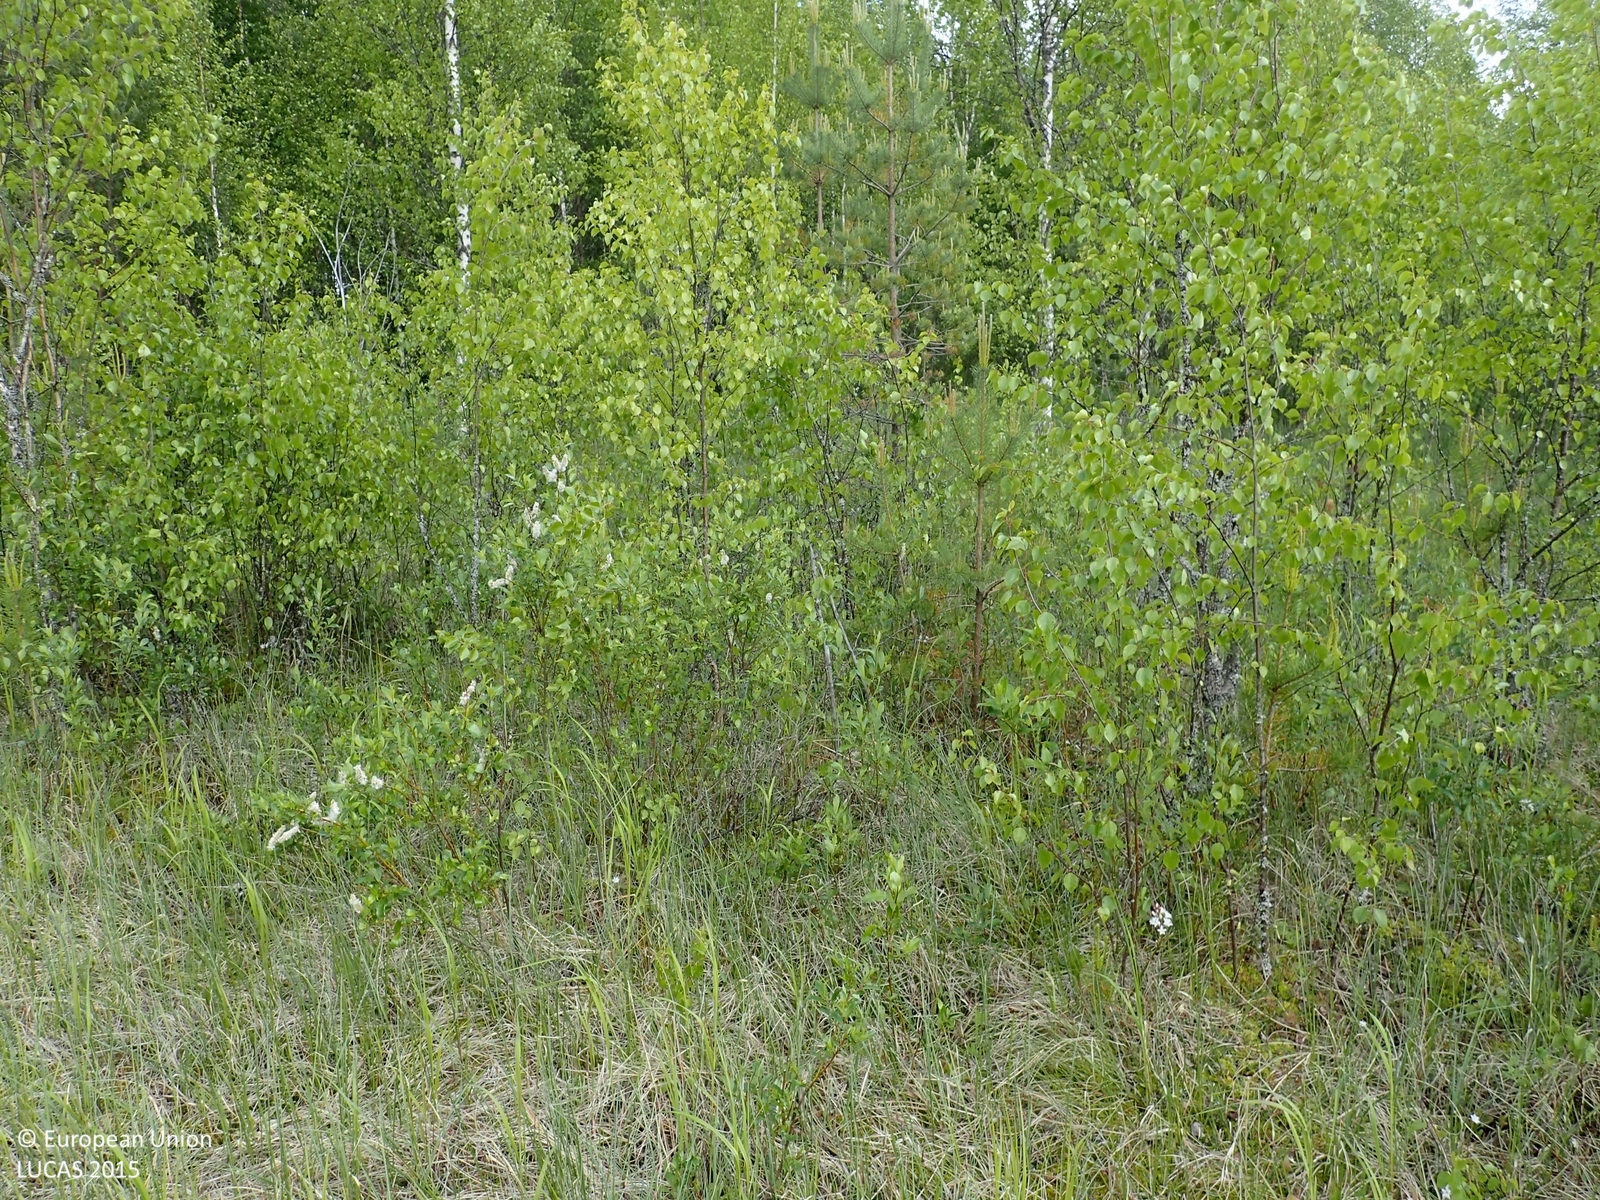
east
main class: Woodland
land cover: Pine dominated mixed woodland
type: mire and swamp forests
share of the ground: 10 - 25 %
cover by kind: herbaceous plants 70 %, broadleaved forest trees 10 %, shrubs 10 %, coniferous forest trees 5 %, lichens and mosses 5 %
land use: Forestry
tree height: < 5 m
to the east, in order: Pine dominated mixed woodland; Grass margins; Ditches and canals; Grass margins; Broadleaved woodland; Ditches and canals; Grass margins; Tracks; Grass margins; Ditches and canals; Grass margins; Barley
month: June
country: FI
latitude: 62.5986
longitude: 23.1728
